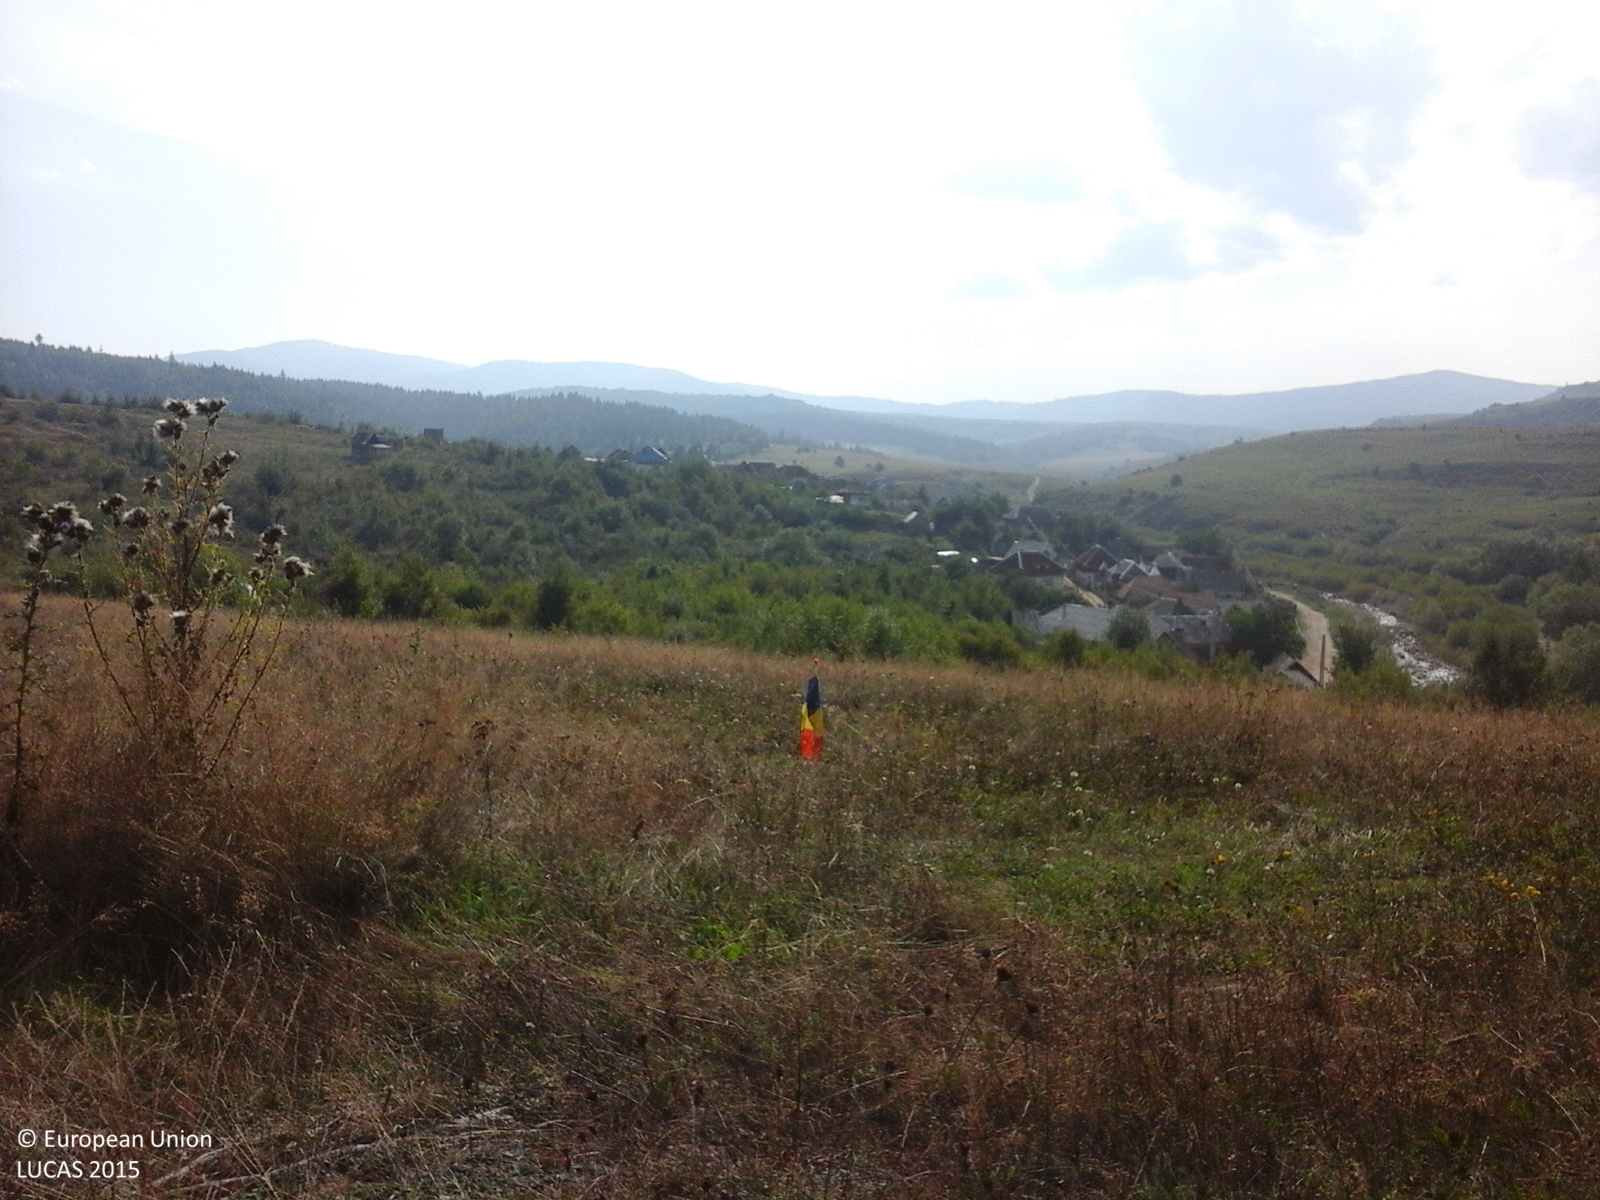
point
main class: Grassland
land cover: Grassland without tree/shrub cover
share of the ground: > 75 %
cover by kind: herbaceous plants 100 %
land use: Agriculture (excluding fallow land and kitchen gardens)
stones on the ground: < 10 %
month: September
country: RO
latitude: 46.7561
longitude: 23.0087
